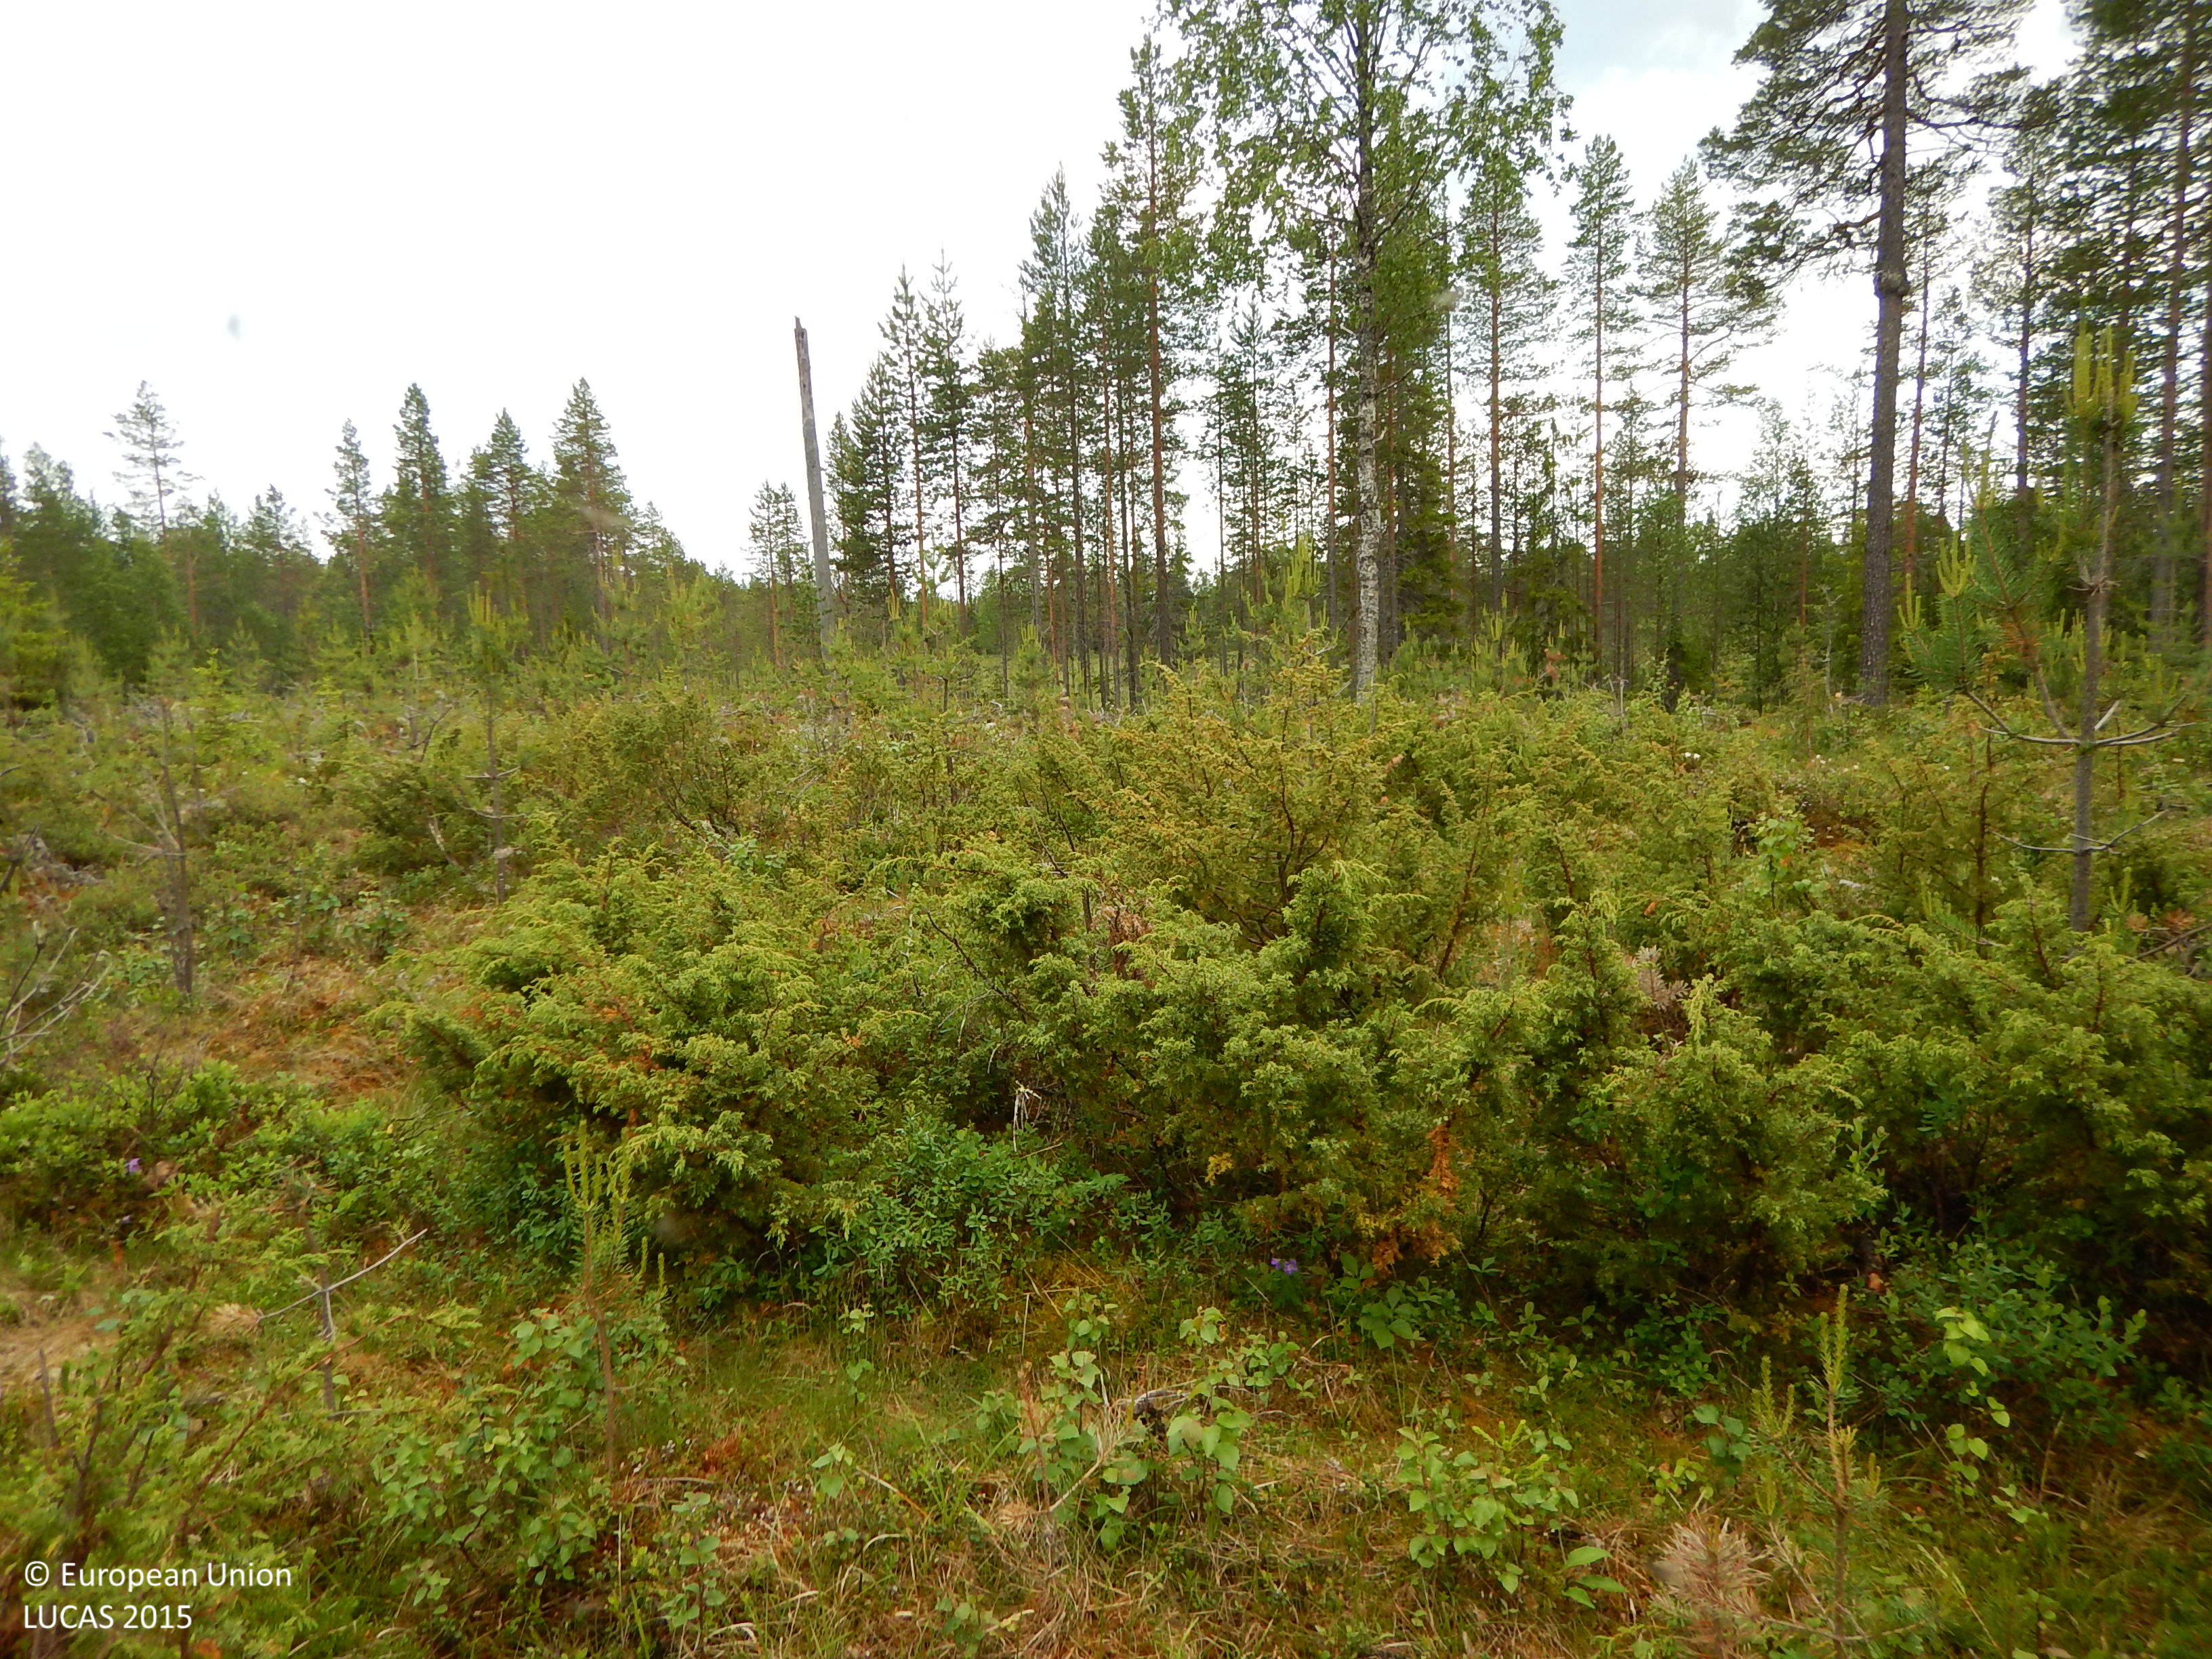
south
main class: Woodland
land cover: Pine dominated coniferous woodland
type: boreal forest
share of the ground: 10 - 25 %
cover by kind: herbaceous plants 45 %, coniferous forest trees 15 %, consolidated bare surface 15 %, shrubs 10 %, lichens and mosses 10 %, broadleaved forest trees 5 %
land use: Forestry
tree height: < 5 m
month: July
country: SE
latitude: 65.2554
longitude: 19.2778
